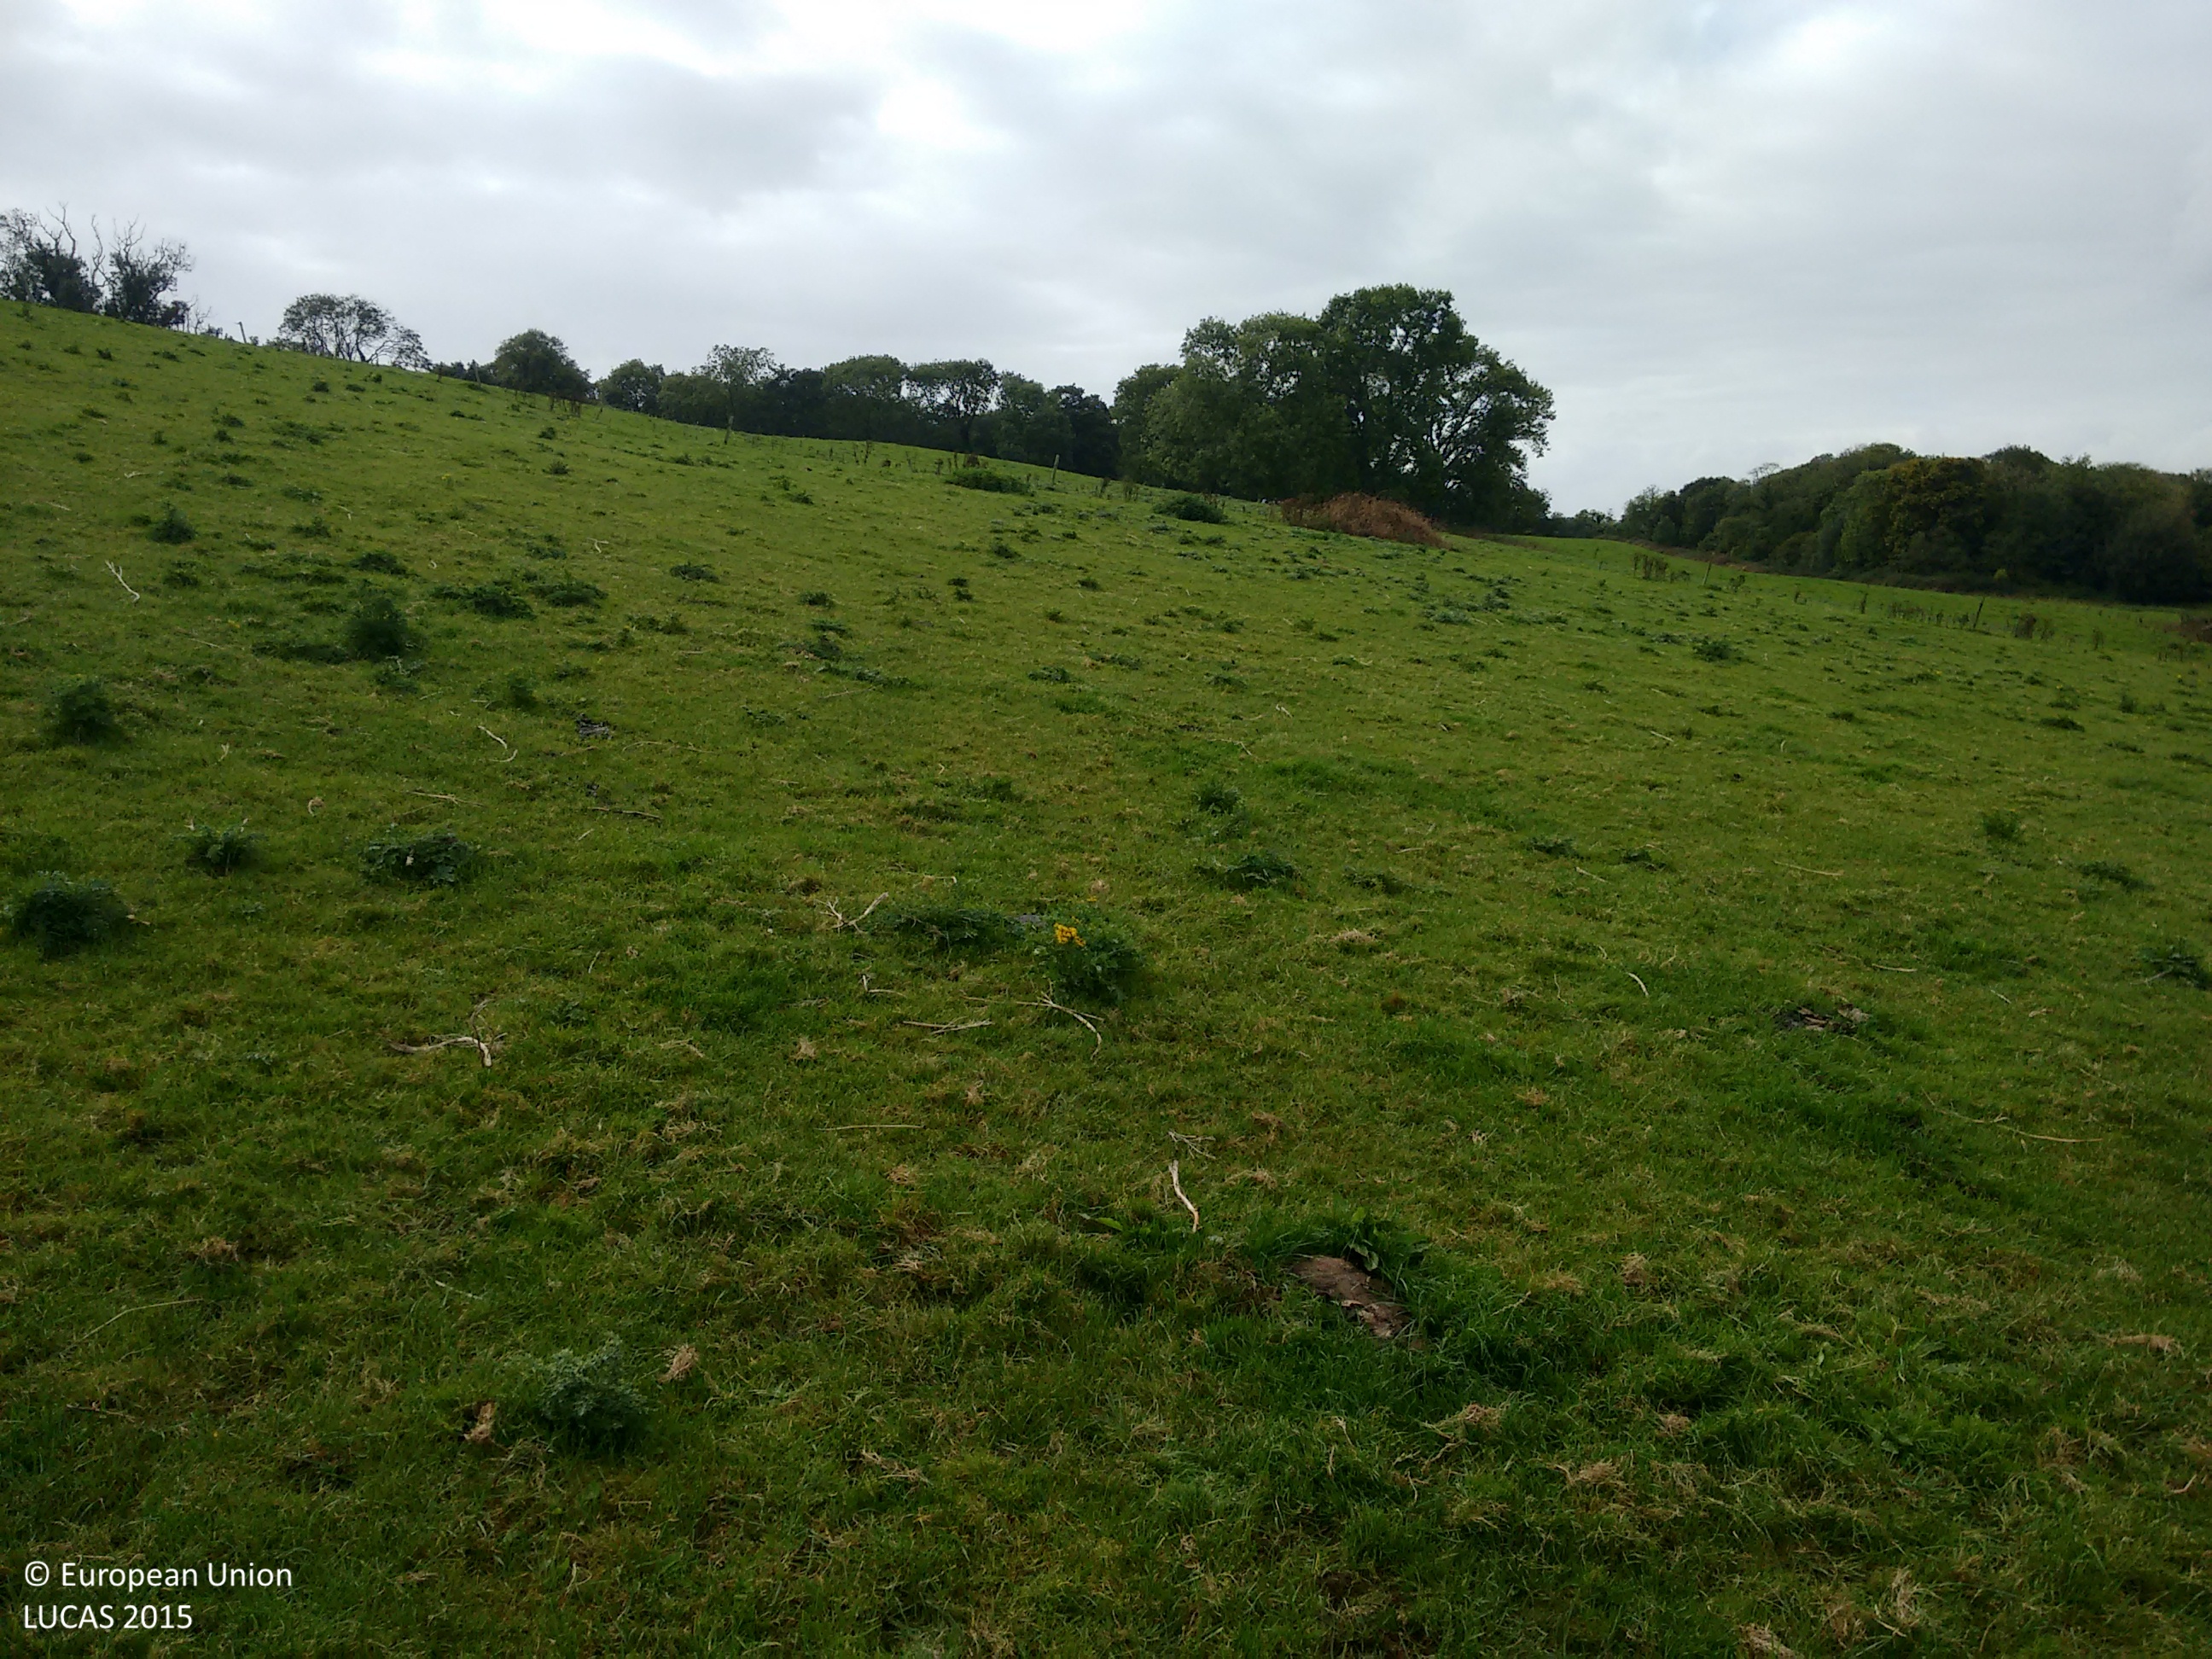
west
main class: Grassland
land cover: Grassland without tree/shrub cover
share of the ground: > 75 %
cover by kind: herbaceous plants 100 %
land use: Agriculture (excluding fallow land and kitchen gardens)
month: September
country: IE
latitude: 52.5672
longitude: -9.3010
